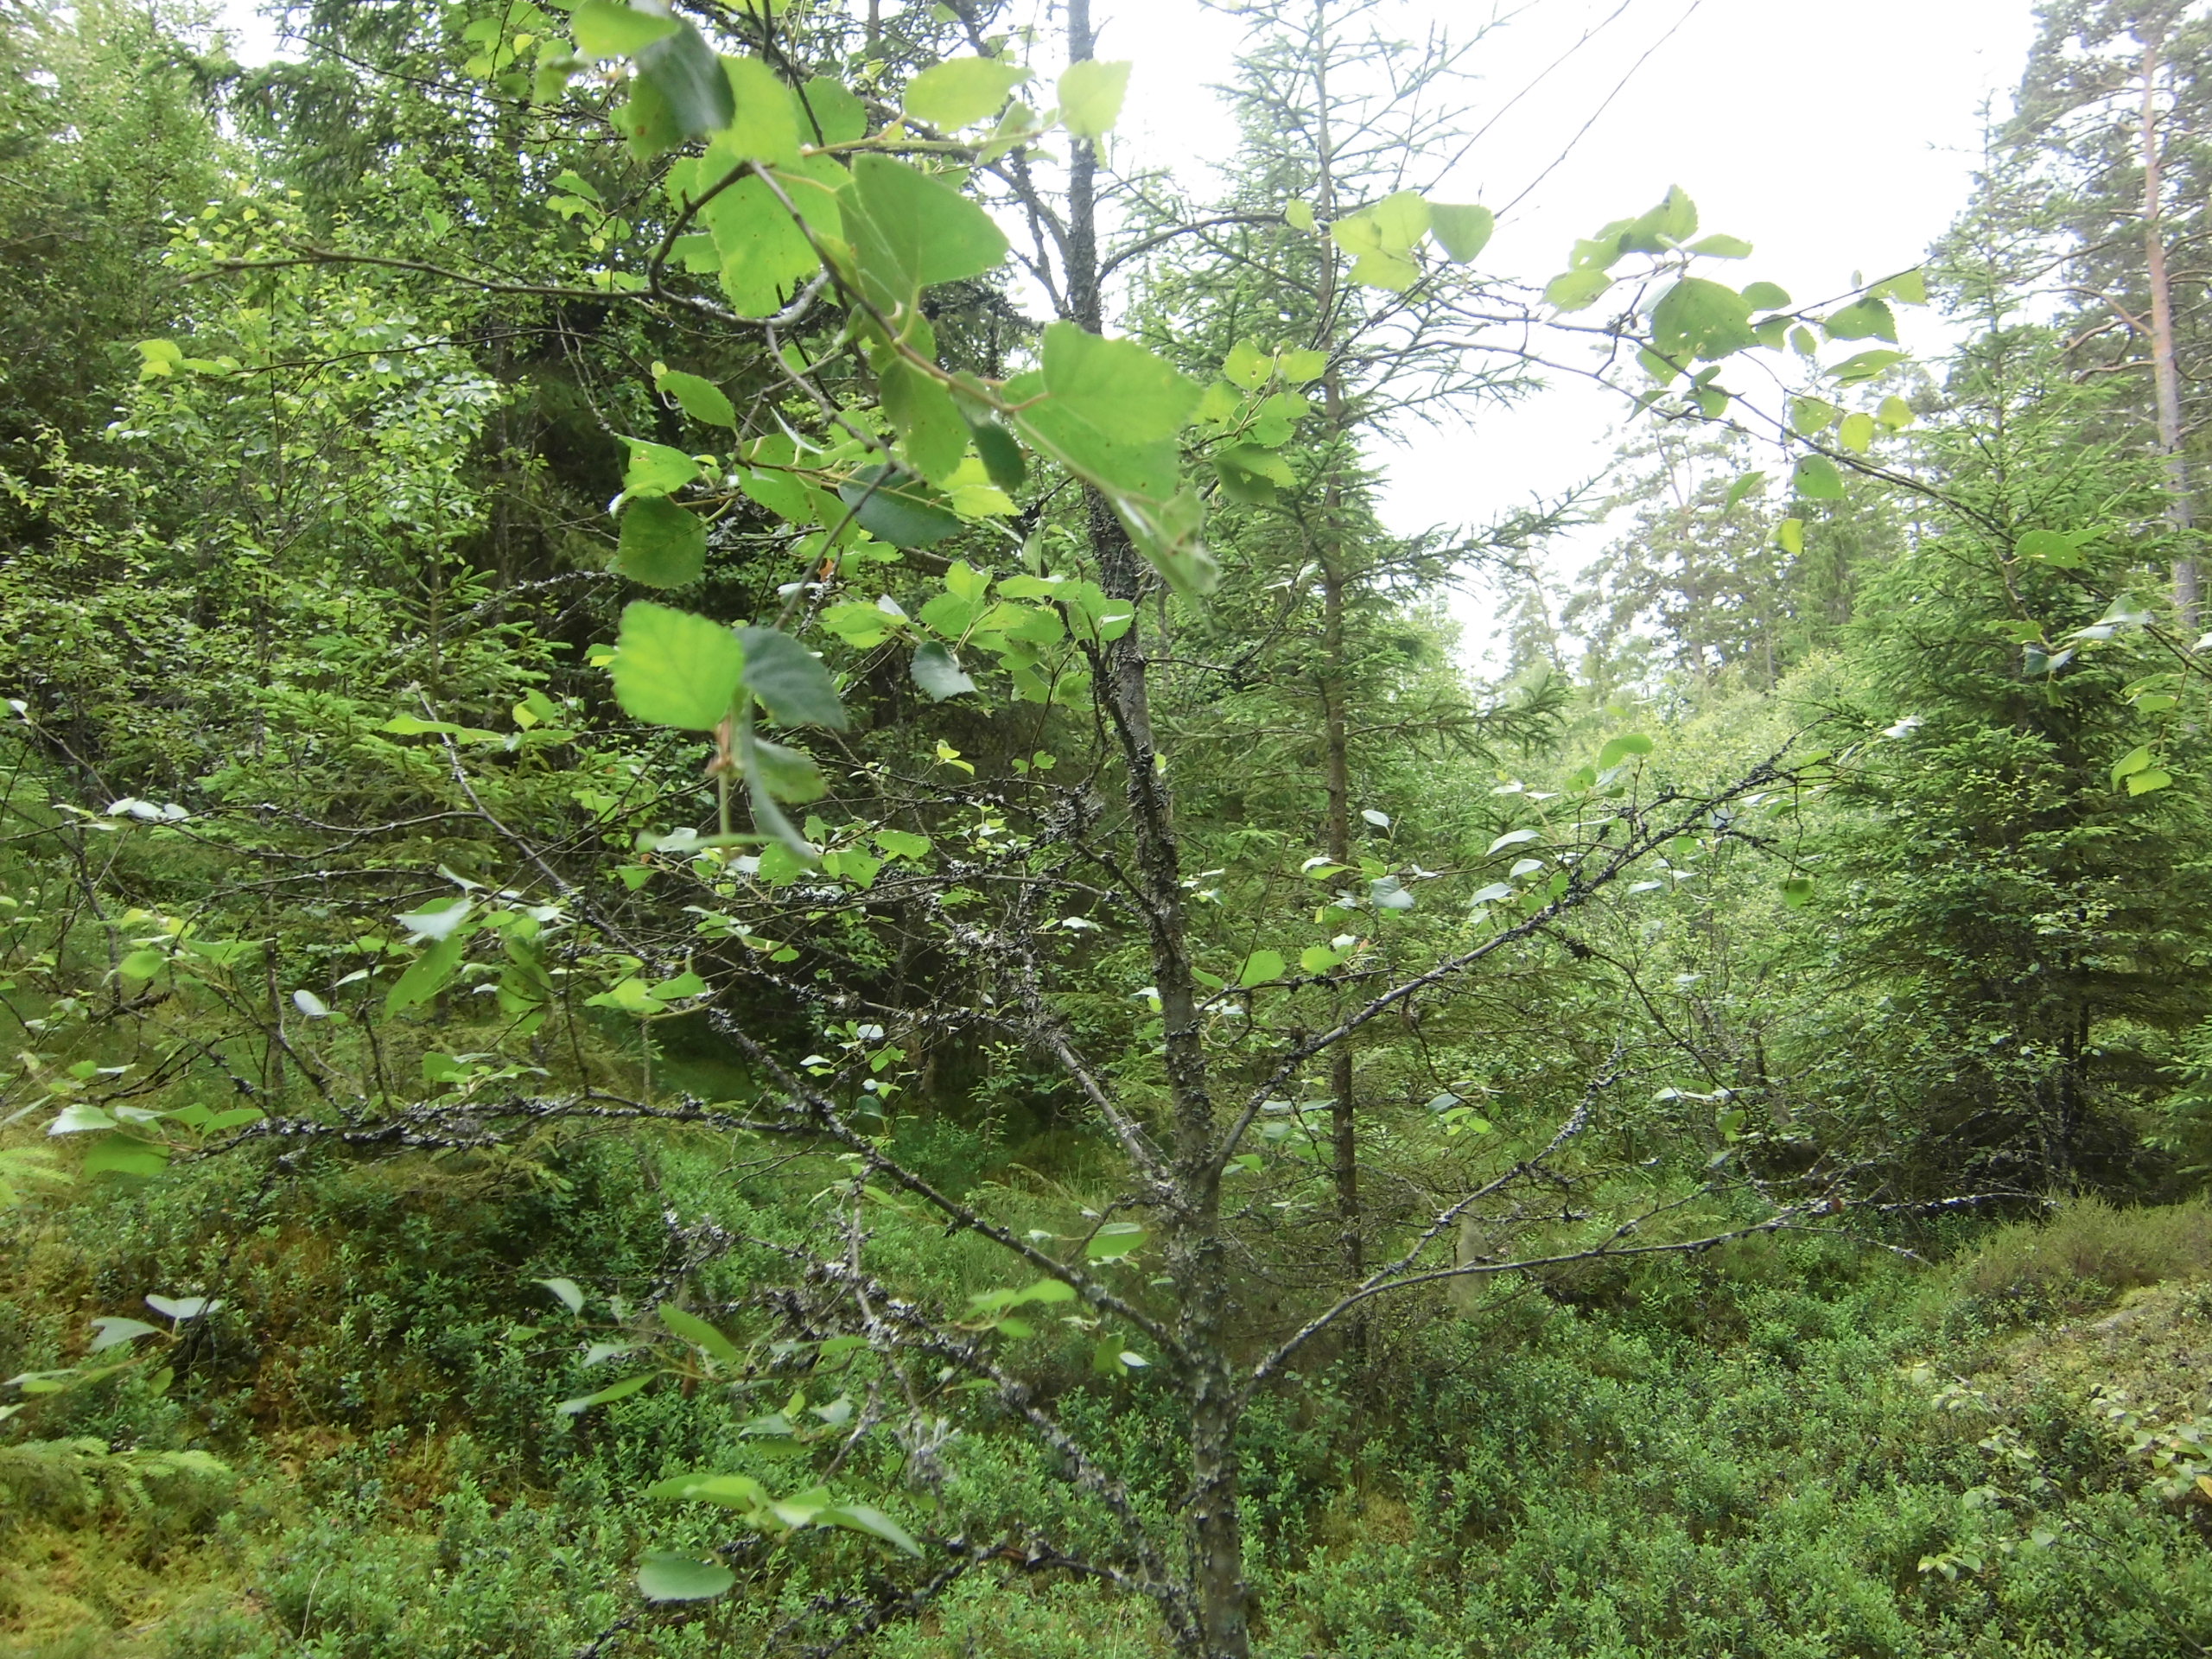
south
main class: Woodland
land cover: Spruce dominated mixed woodland
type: boreal forest
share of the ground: 50 - 75 %
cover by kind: coniferous forest trees 30 %, shrubs 25 %, broadleaved forest trees 20 %, lichens and mosses 15 %, herbaceous plants 10 %
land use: Forestry
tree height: > 5 m
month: July
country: SE
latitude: 57.2723
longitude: 15.1876
